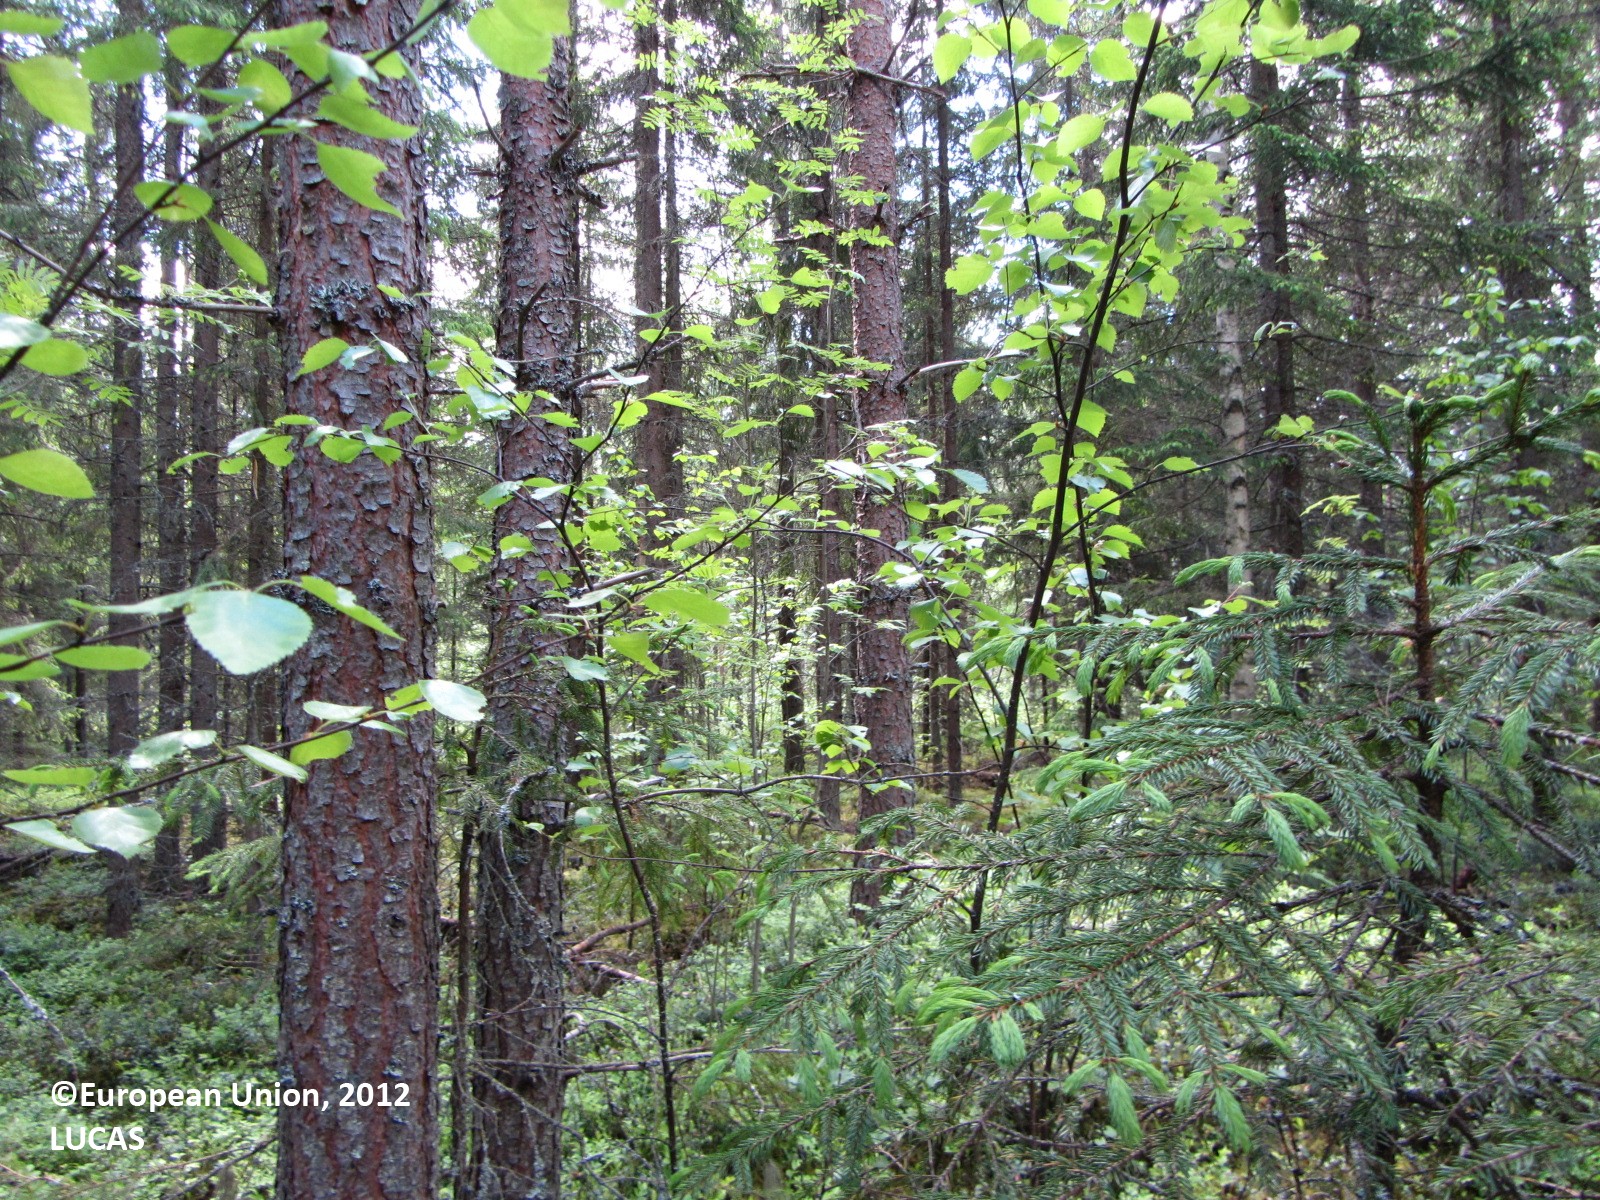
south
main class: Woodland
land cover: Spruce dominated mixed woodland
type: boreal forest
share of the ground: 50 - 75 %
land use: Forestry
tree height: > 5 m
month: June
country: FI
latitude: 62.0253
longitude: 24.9519
